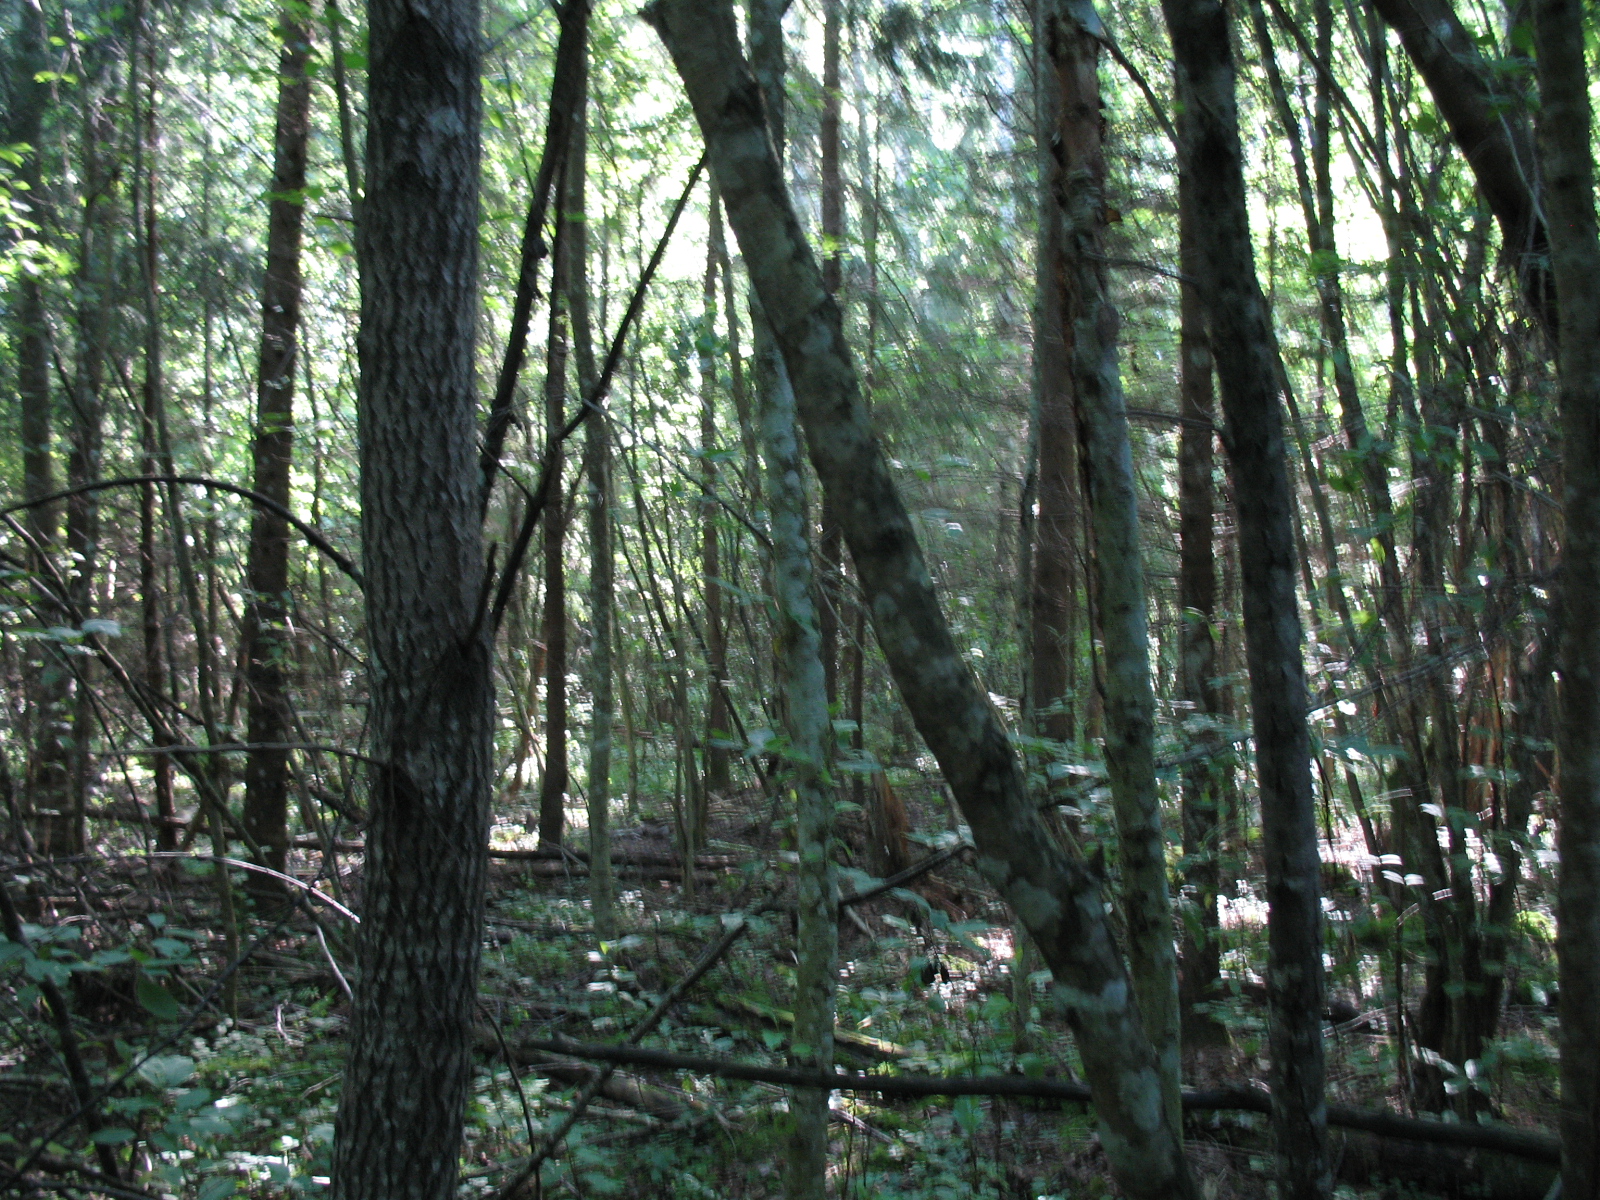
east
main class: Woodland
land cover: Broadleaved woodland
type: non-riverine alder, birch or aspen forest
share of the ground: > 75 %
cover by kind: broadleaved forest trees 90 %, shrubs 5 %, herbaceous plants 5 %
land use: Forestry
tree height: > 5 m
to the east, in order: Broadleaved woodland; Spruce dominated mixed woodland; Broadleaved woodland; Spruce dominated mixed woodland; Broadleaved woodland; Ditches and canals; Broadleaved woodland
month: July
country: LV
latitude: 56.2224
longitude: 25.0937
